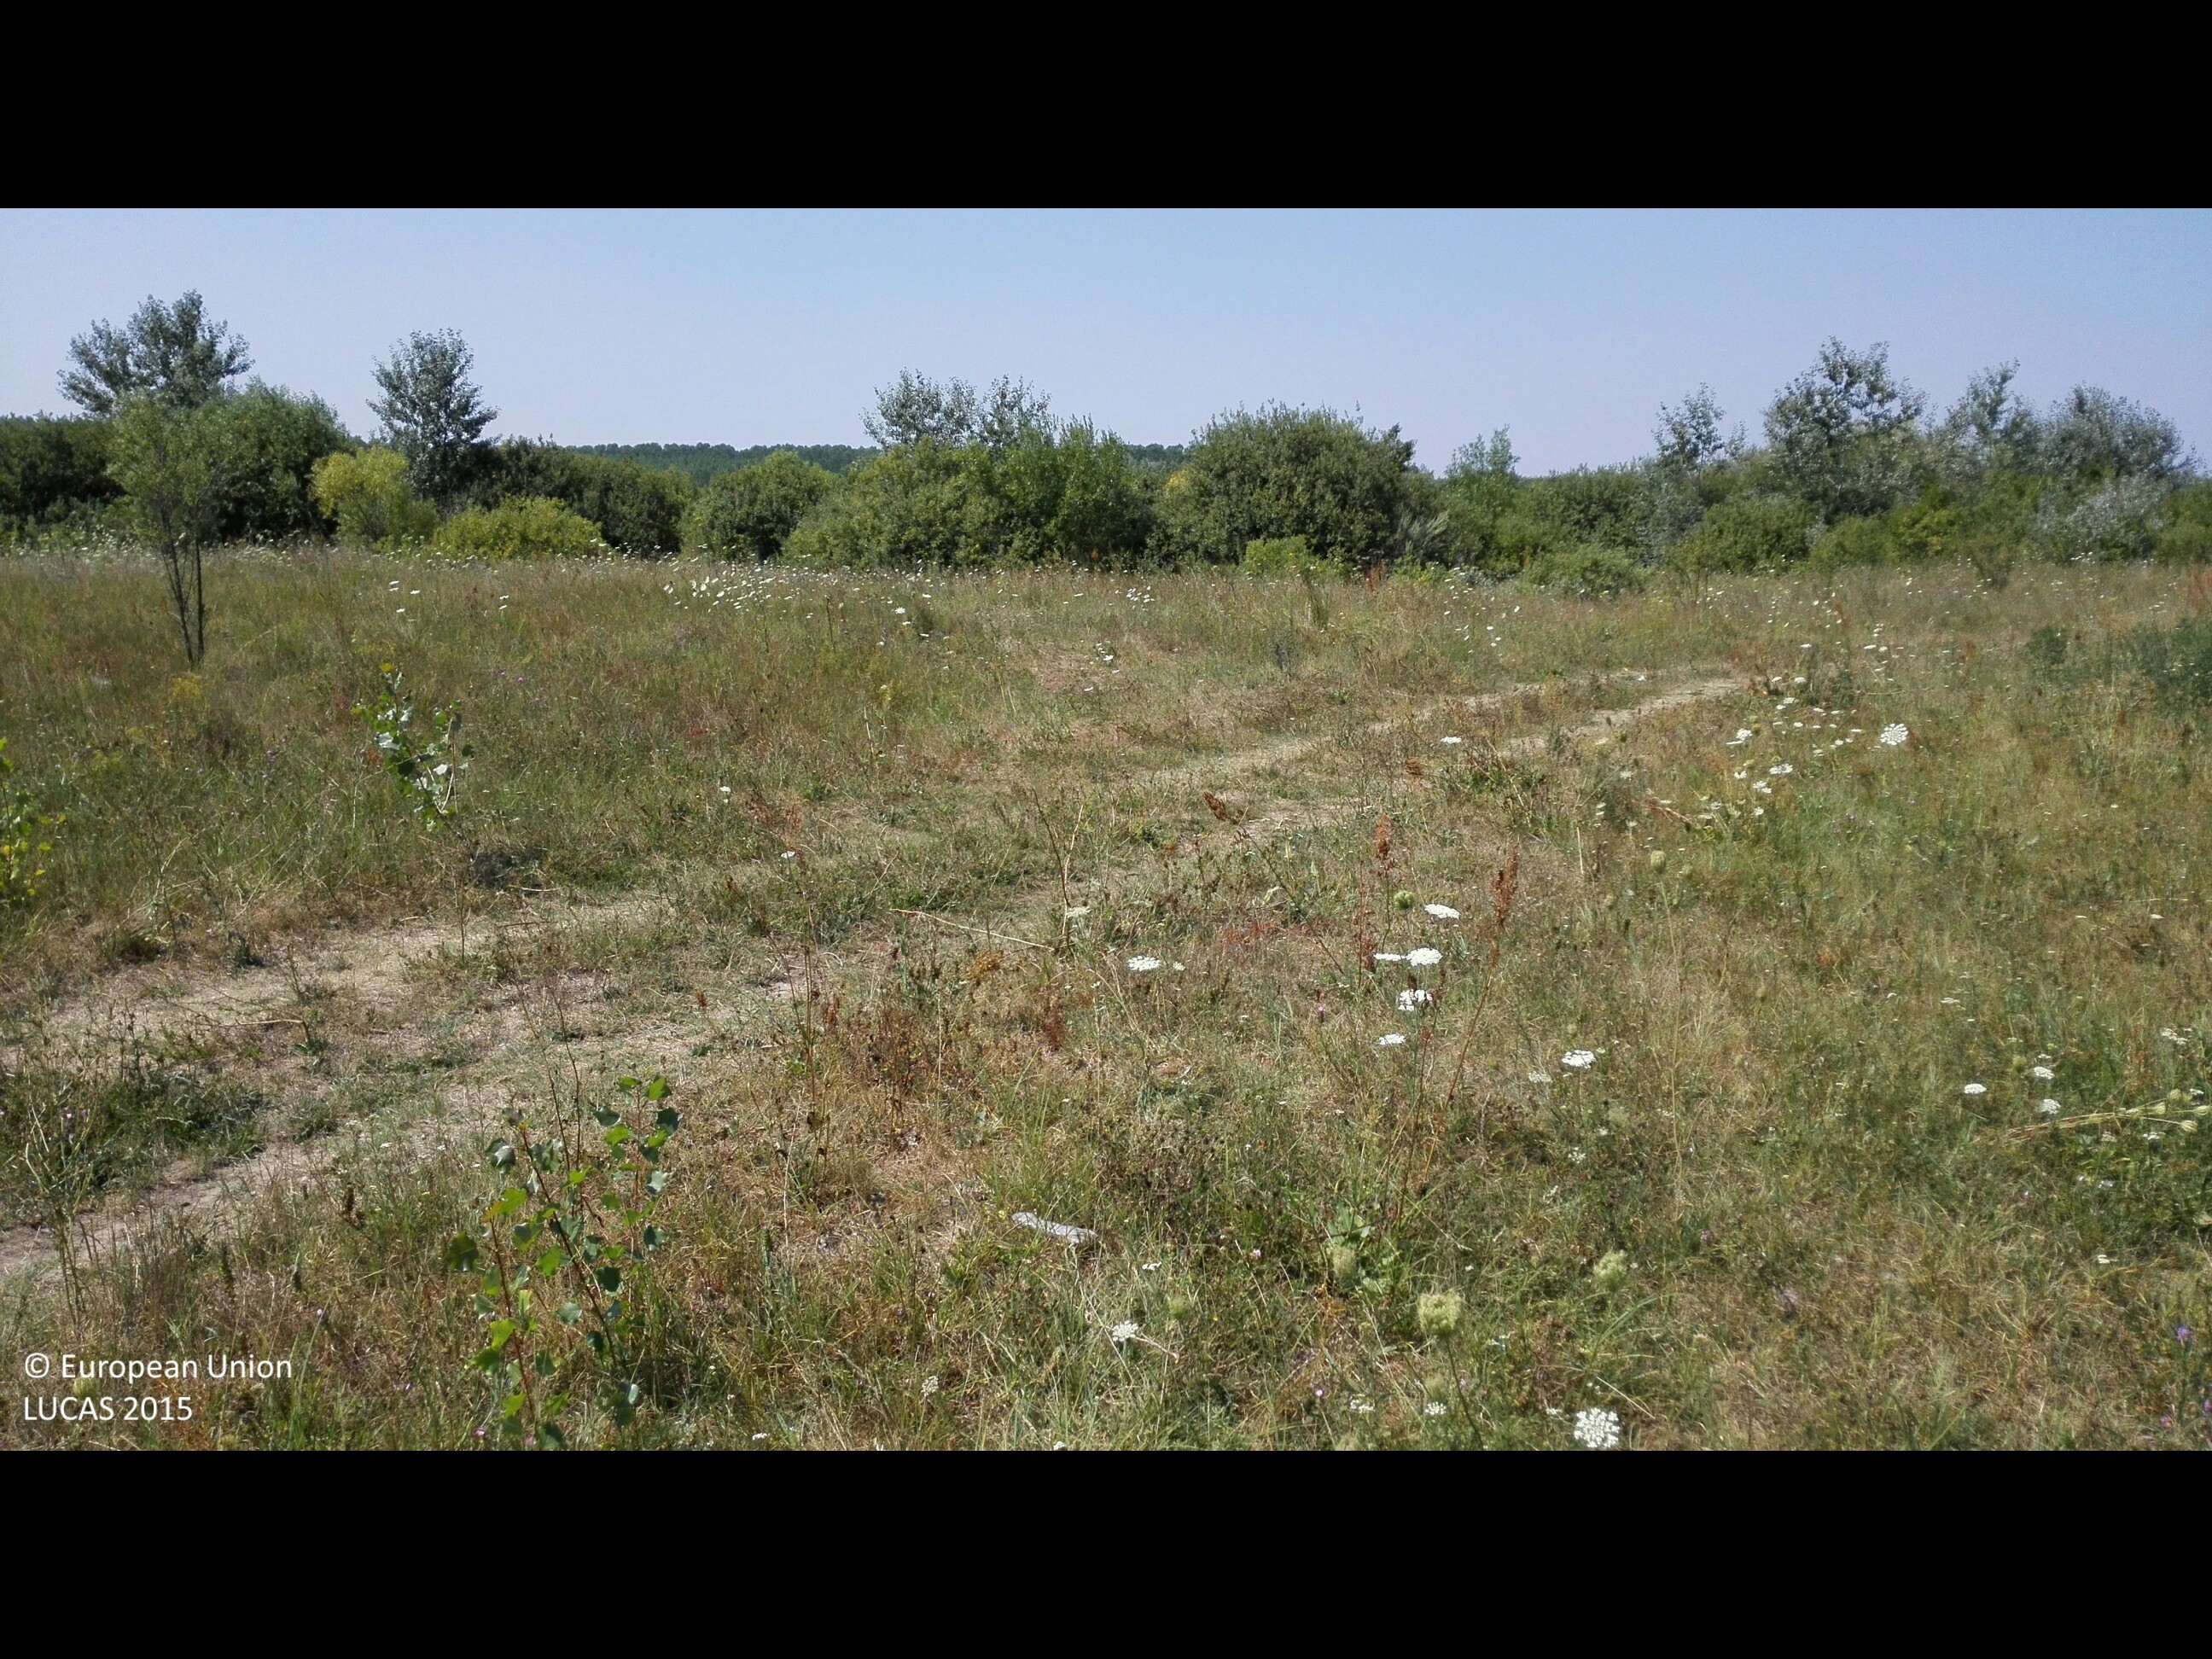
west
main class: Grassland
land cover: Grassland with sparse tree/shrub cover
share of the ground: > 75 %
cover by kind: herbaceous plants 90 %, broadleaved forest trees 5 %, shrubs 5 %
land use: Semi-natural and natural areas not in use
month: August
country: HU
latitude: 47.5625
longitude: 22.0254
